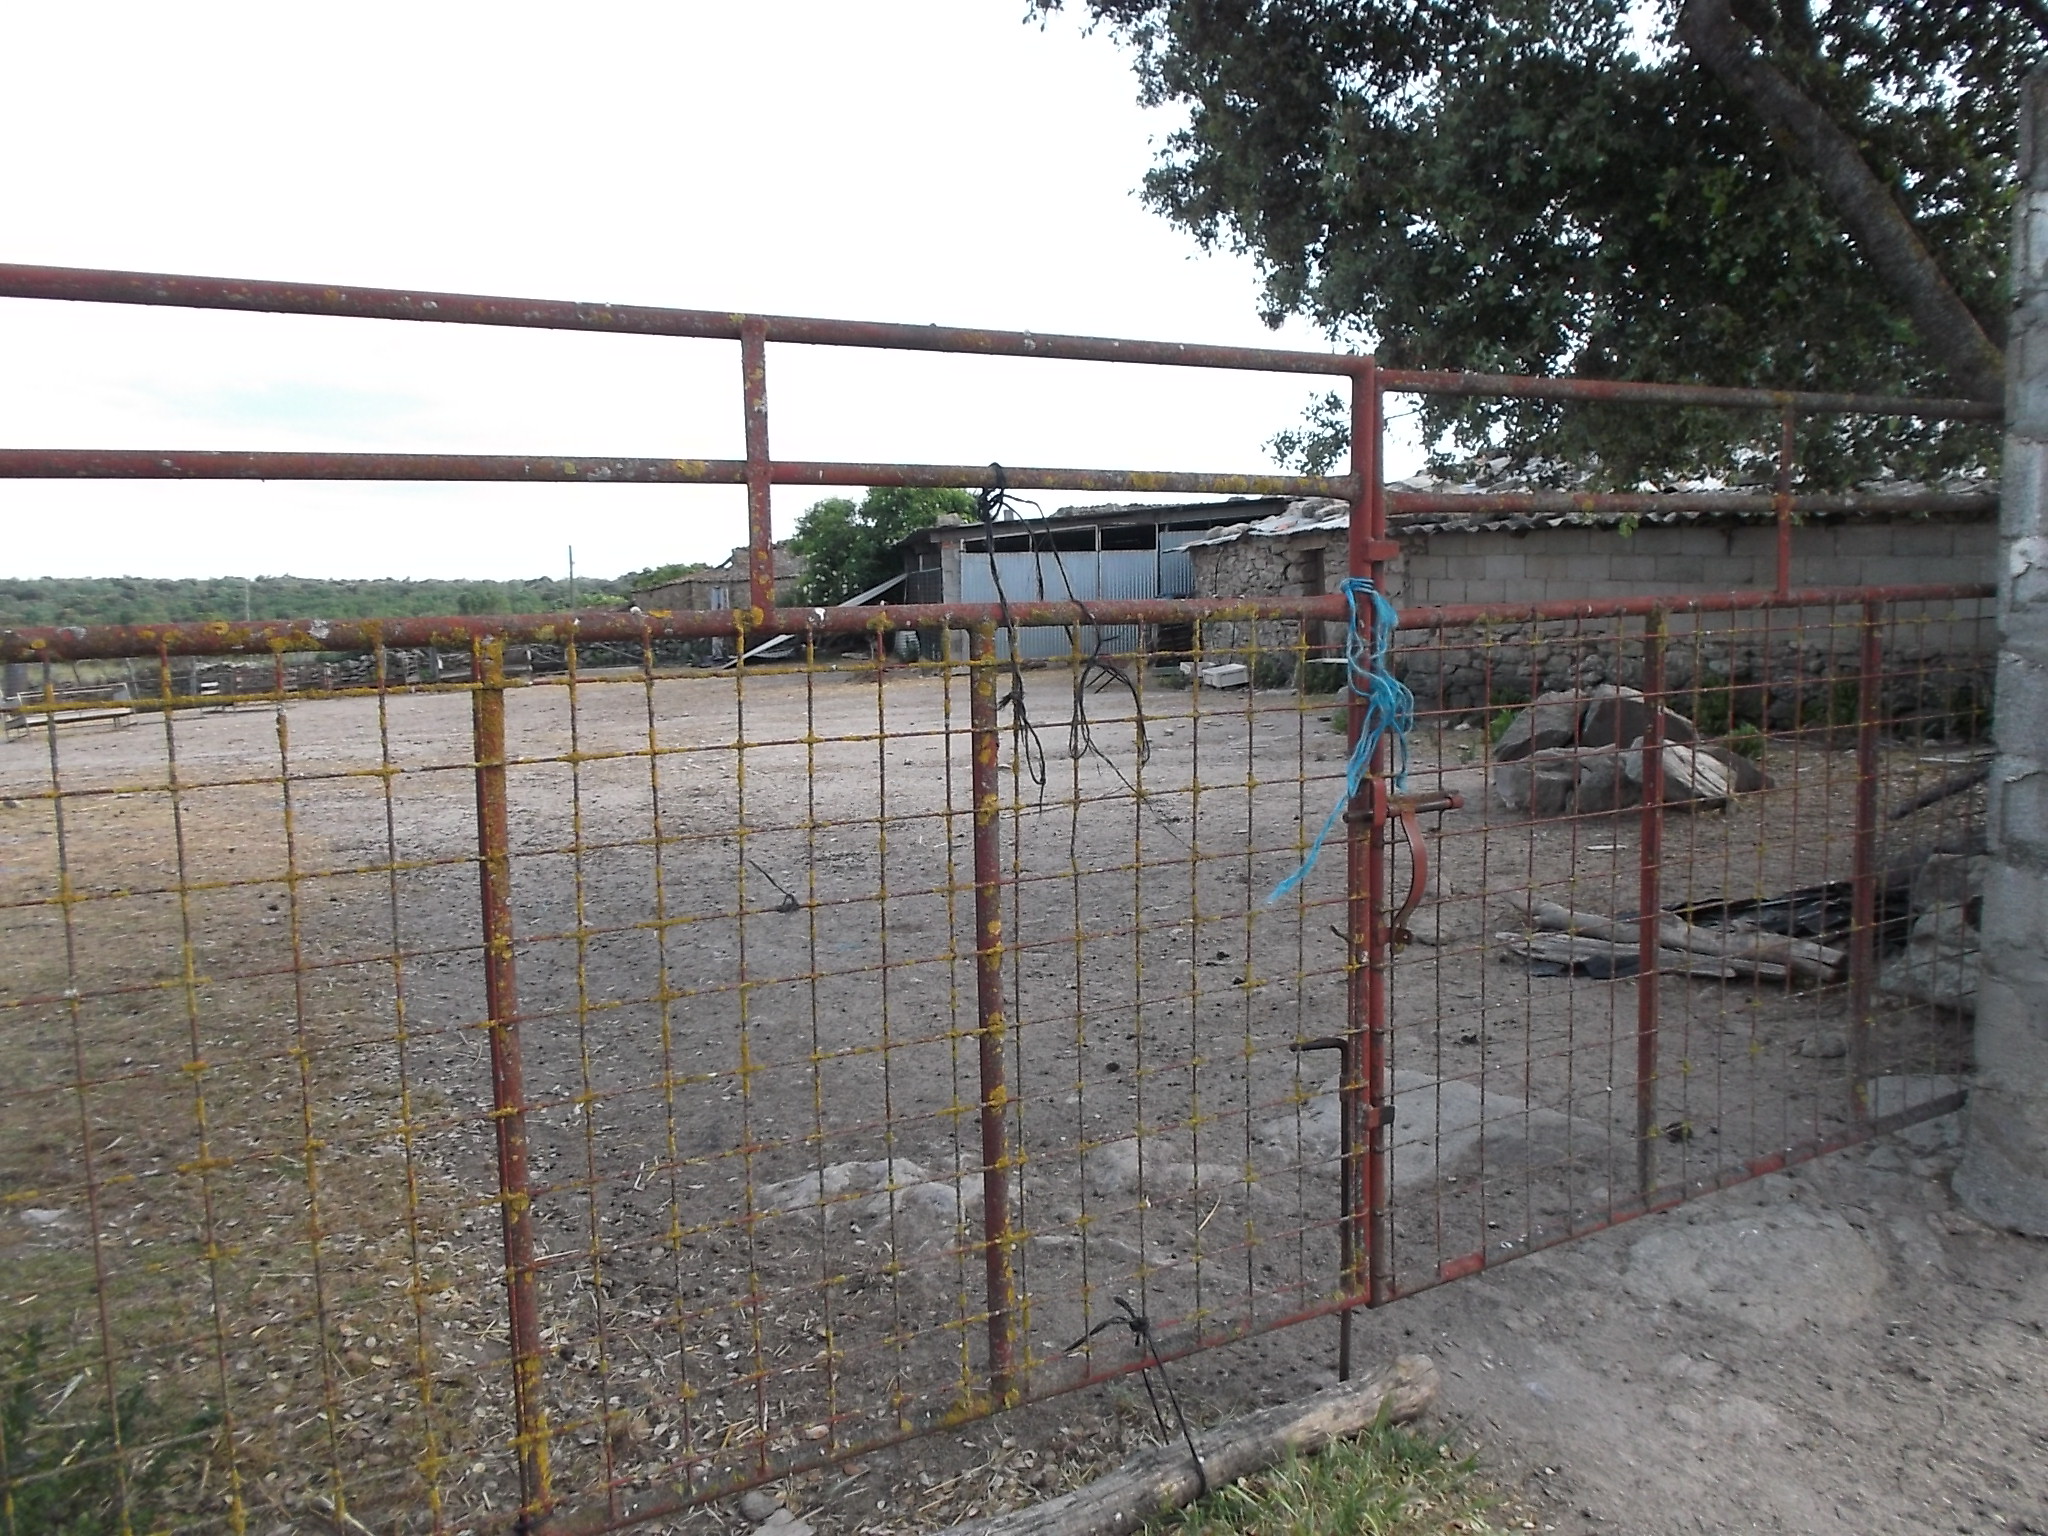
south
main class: Grassland
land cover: Grassland without tree/shrub cover
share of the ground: > 75 %
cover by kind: herbaceous plants 100 %
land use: Agriculture (excluding fallow land and kitchen gardens)
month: May
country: ES
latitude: 41.1127
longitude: -6.3491
